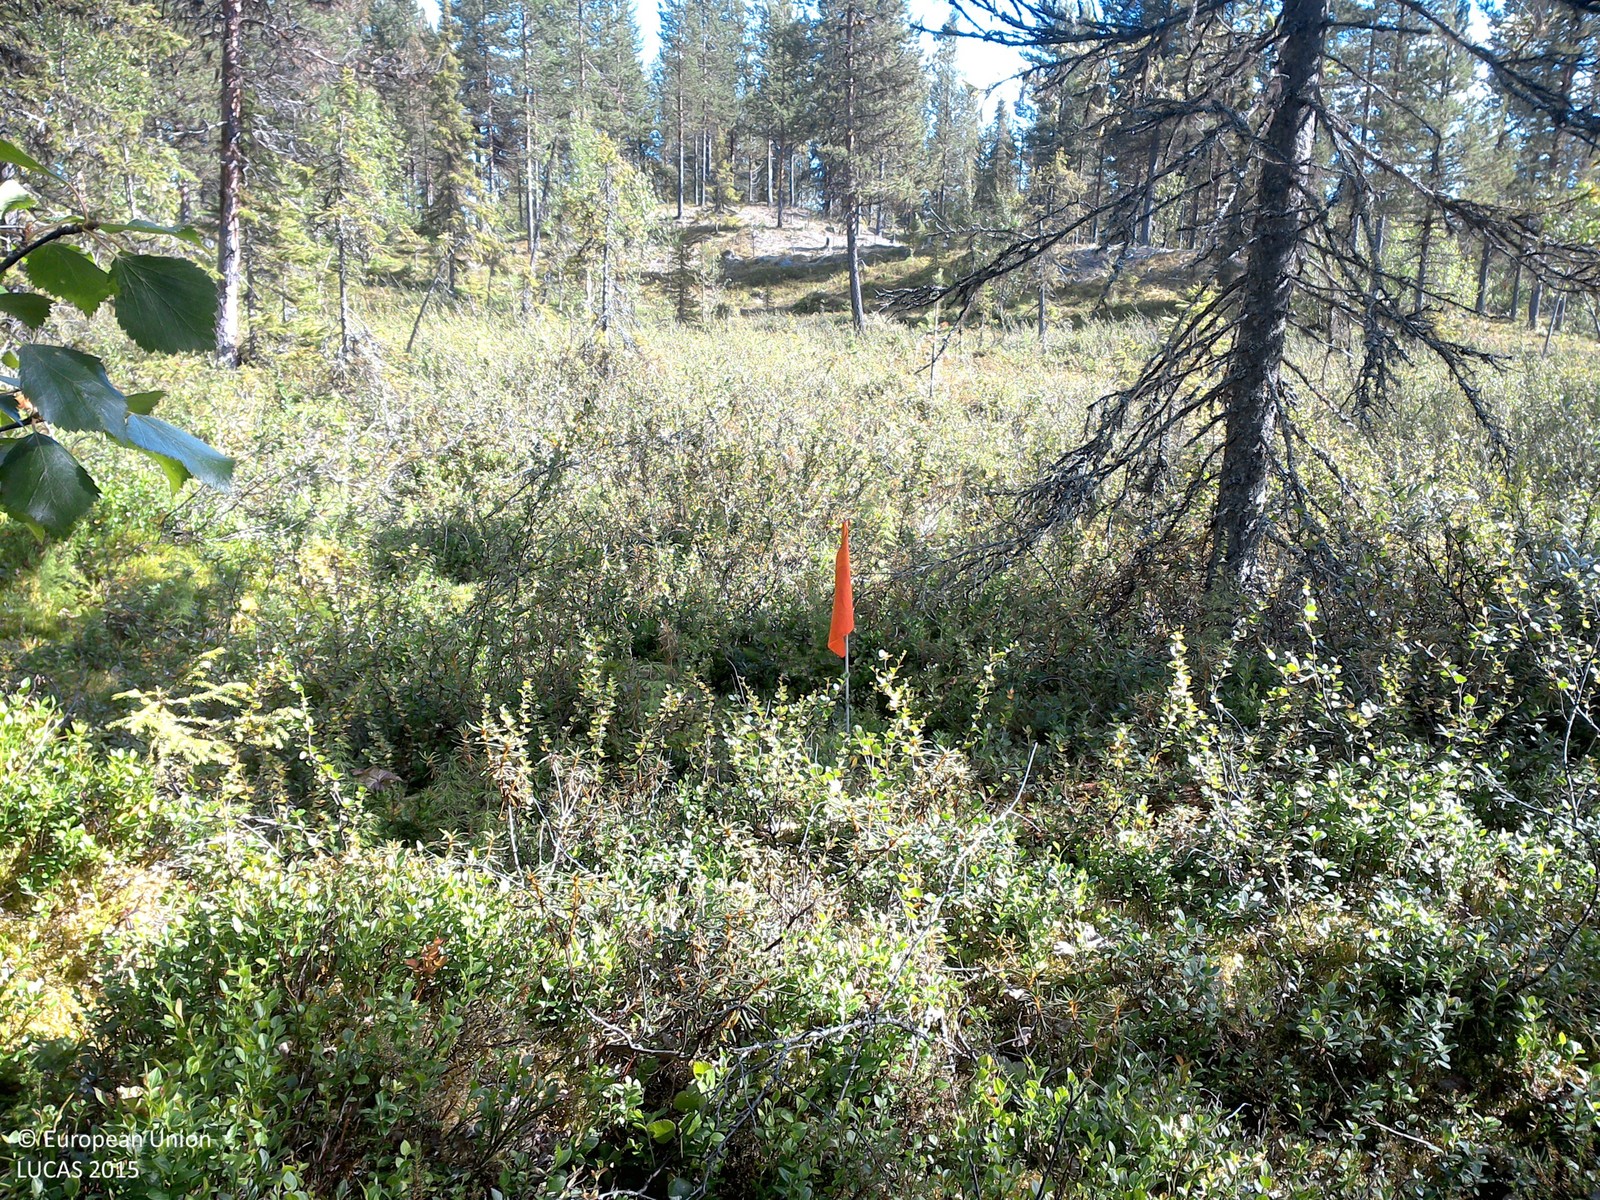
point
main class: Woodland
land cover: Pine dominated mixed woodland
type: boreal forest
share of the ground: 25 - 50 %
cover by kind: shrubs 70 %, coniferous forest trees 15 %, broadleaved forest trees 10 %, lichens and mosses 5 %
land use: Forestry
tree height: > 5 m
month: August
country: SE
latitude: 67.4227
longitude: 21.2223
